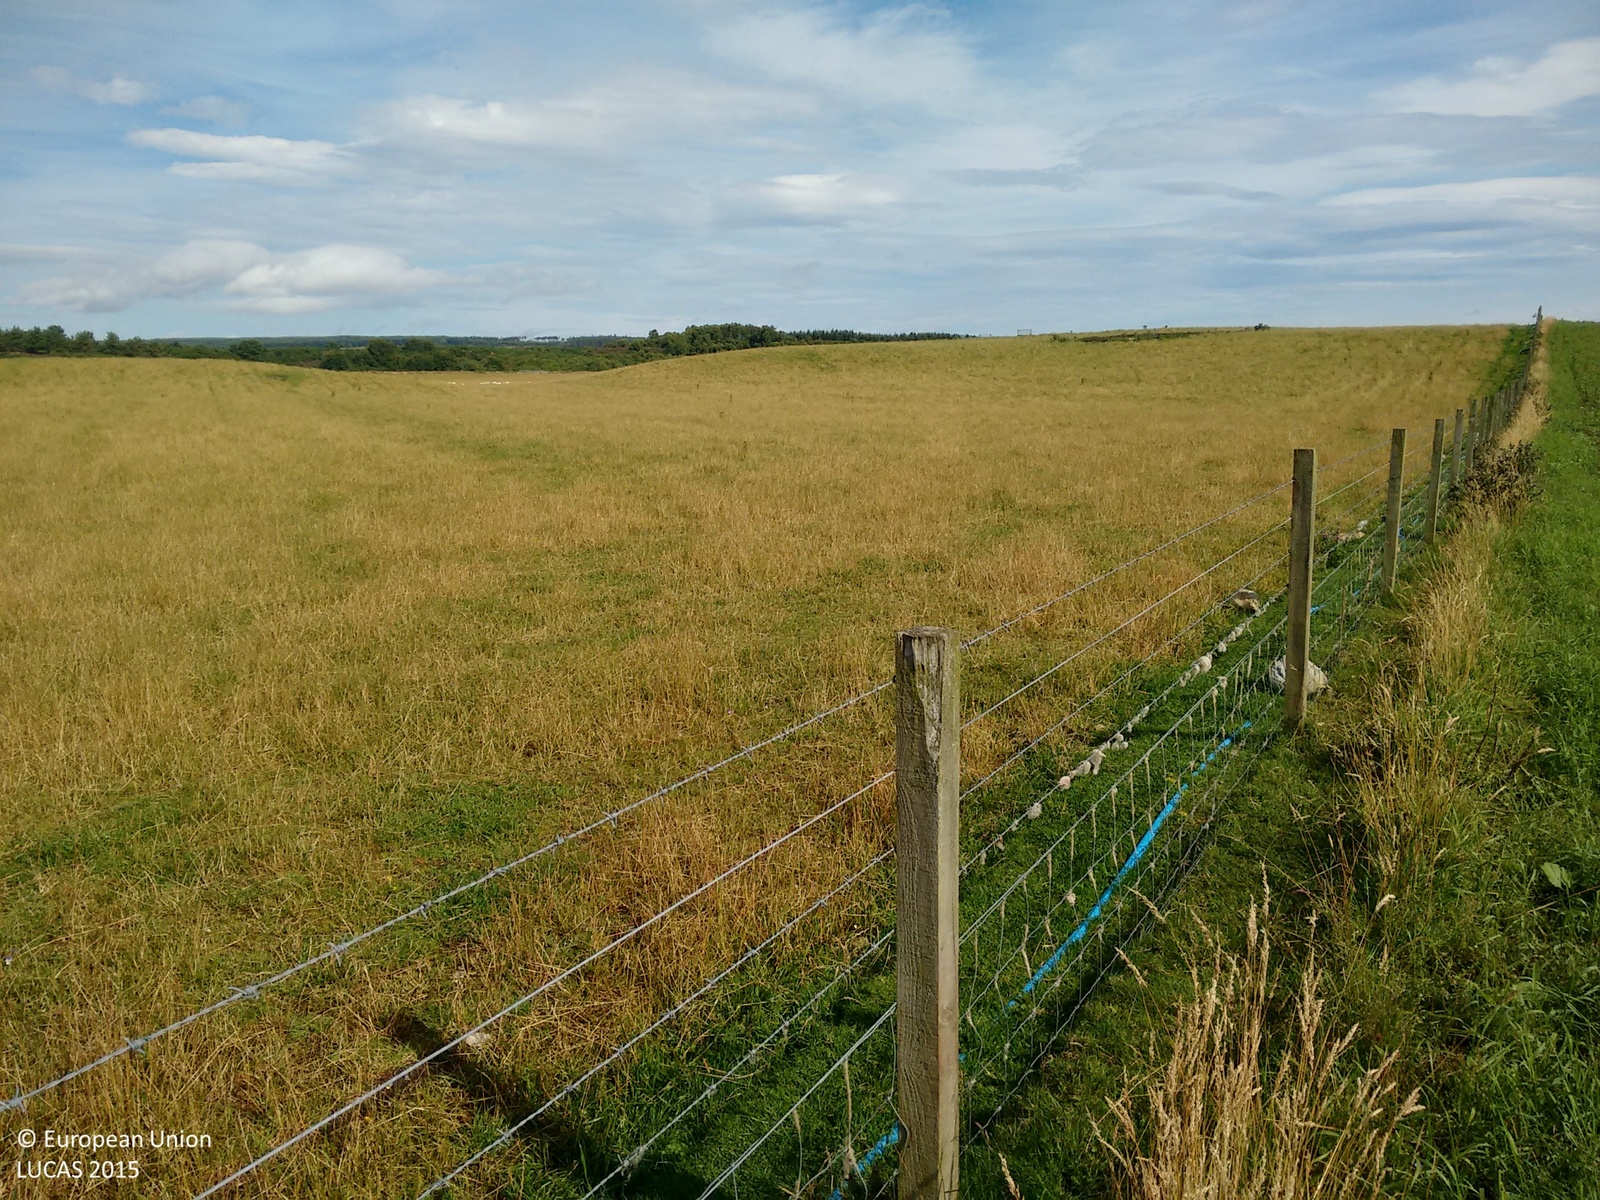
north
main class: Grassland
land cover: Spontaneously vegetated surfaces
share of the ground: 50 - 75 %
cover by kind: herbaceous plants 75 %, unconsolidated bare surface 25 %
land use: Agriculture (excluding fallow land and kitchen gardens)
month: August
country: GB
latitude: 57.8781
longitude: -4.0580
